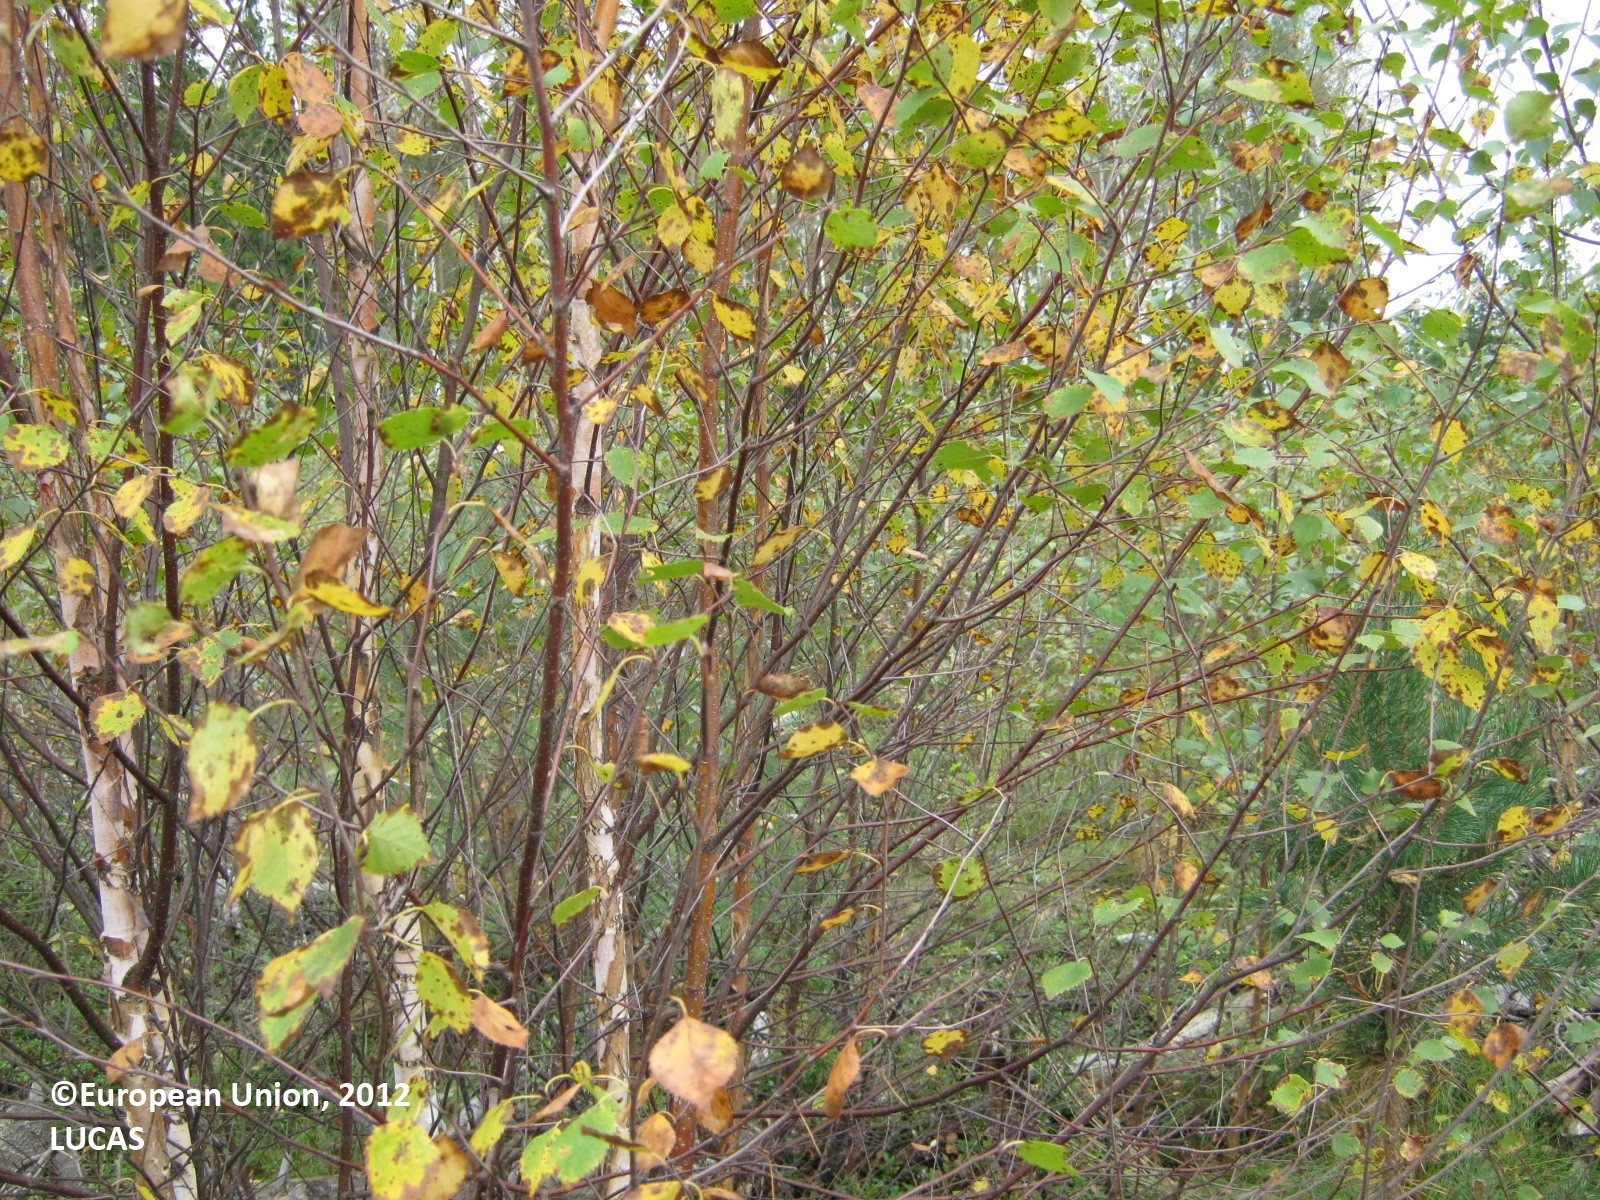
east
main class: Woodland
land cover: Broadleaved woodland
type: boreal forest
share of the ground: > 75 %
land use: Forestry
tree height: < 5 m
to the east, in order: Broadleaved woodland; Spruce dominated coniferous woodland; Spruce dominated mixed woodland; Broadleaved woodland
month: September
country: FI
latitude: 60.6592
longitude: 27.5491
